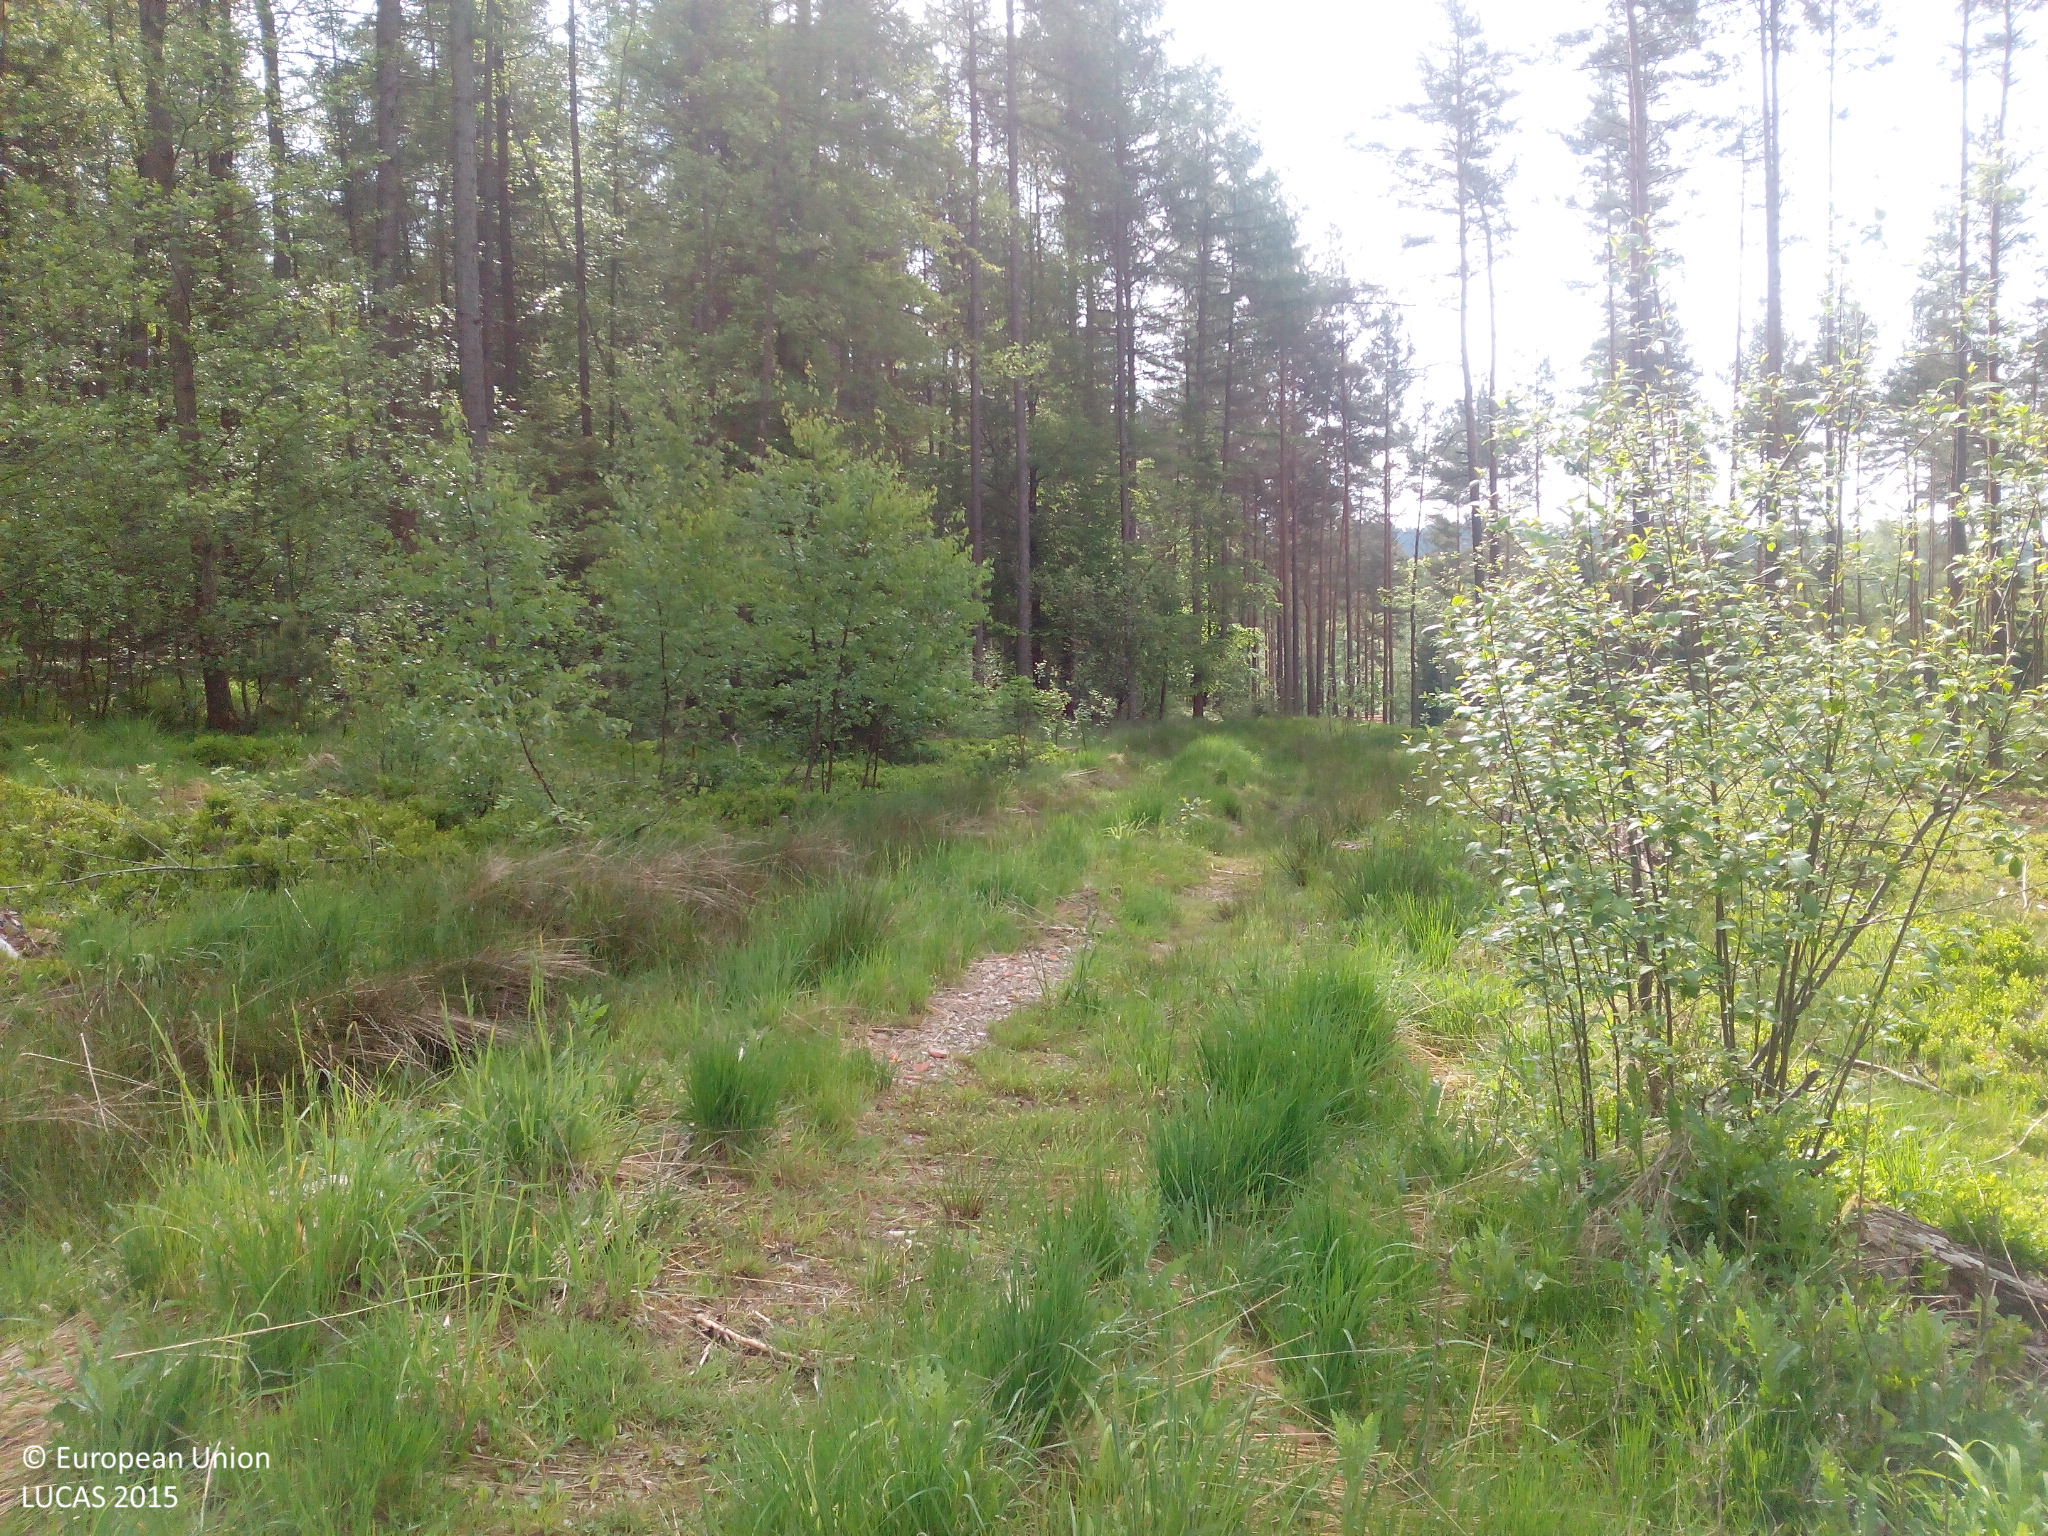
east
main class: Shrubland
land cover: Shrubland without tree cover
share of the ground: 50 - 75 %
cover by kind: shrubs 70 %, herbaceous plants 25 %, unconsolidated bare surface 5 %
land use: Forestry
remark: Clear cut
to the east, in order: Shrubland without tree cover; Tracks; Pine dominated mixed woodland; Tracks; Pine dominated mixed woodland; Tracks; Pine dominated mixed woodland; Pine dominated coniferous woodland
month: May
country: DE
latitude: 49.7961
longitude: 11.5416
